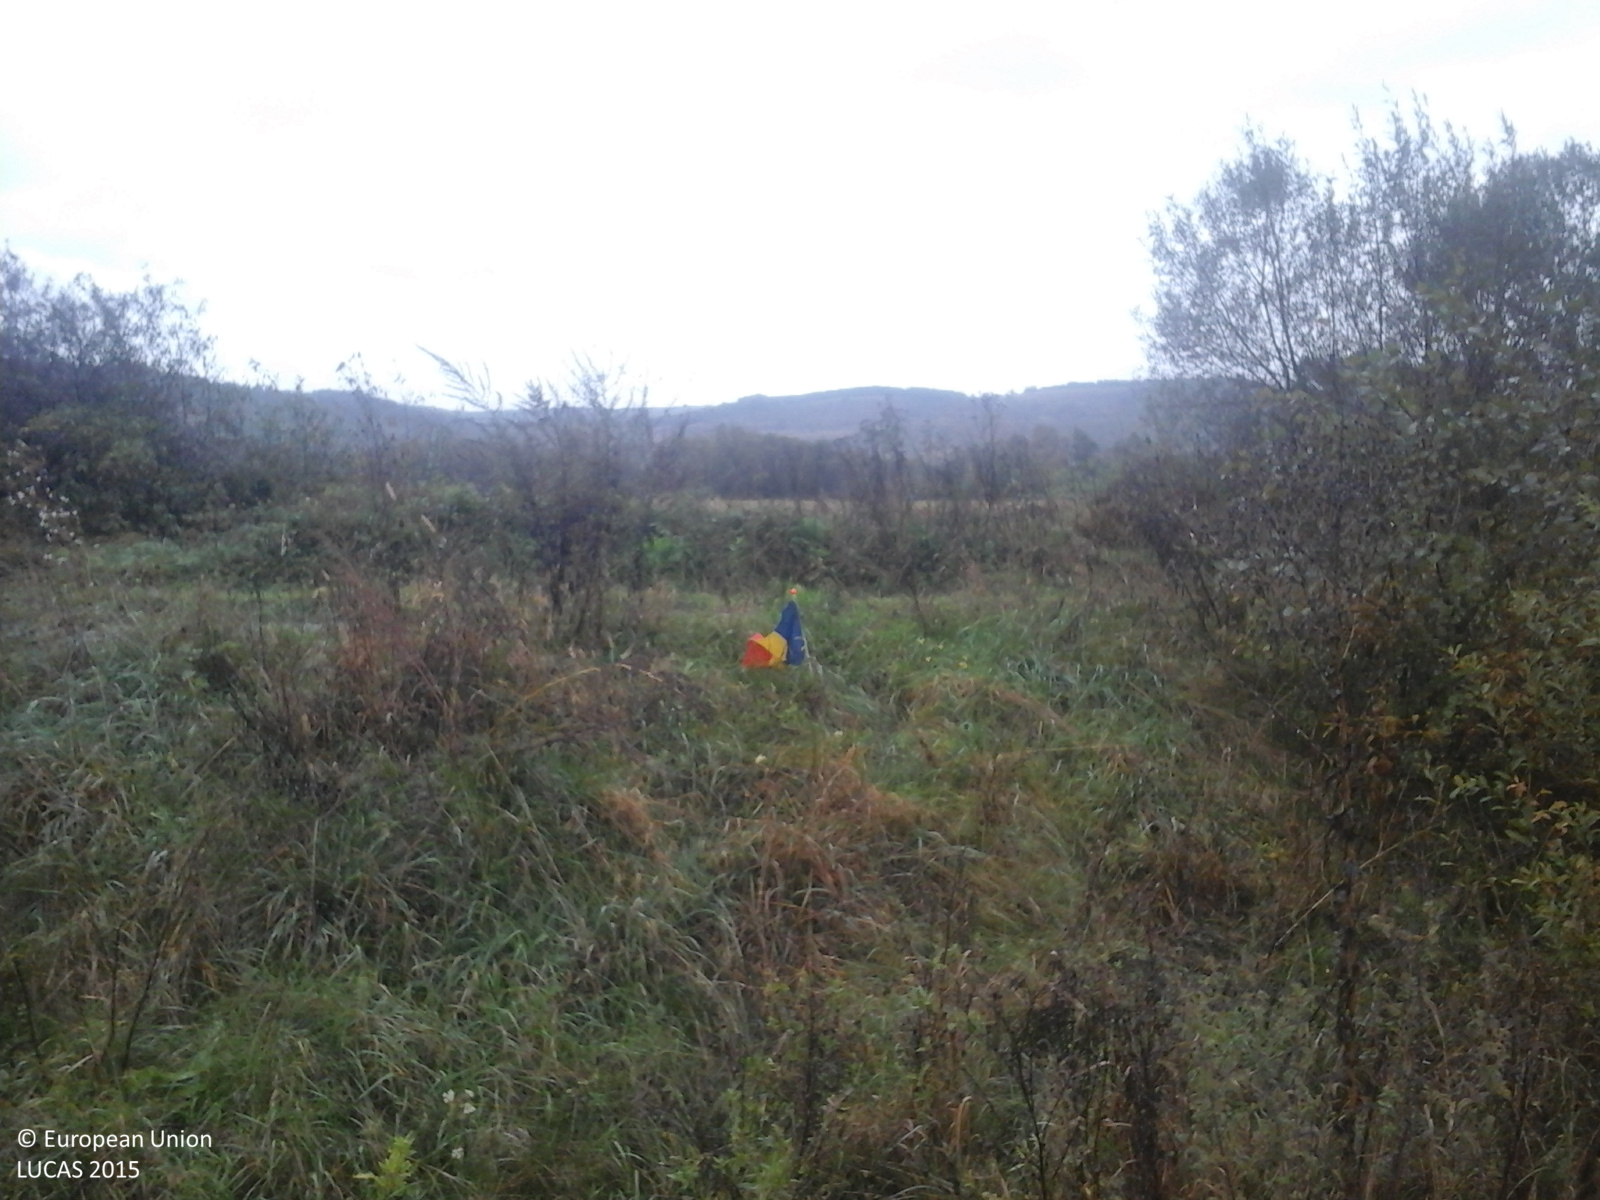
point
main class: Grassland
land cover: Spontaneously vegetated surfaces
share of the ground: > 75 %
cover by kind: herbaceous plants 100 %
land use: Fallow land
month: October
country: RO
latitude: 45.7917
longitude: 24.6601
